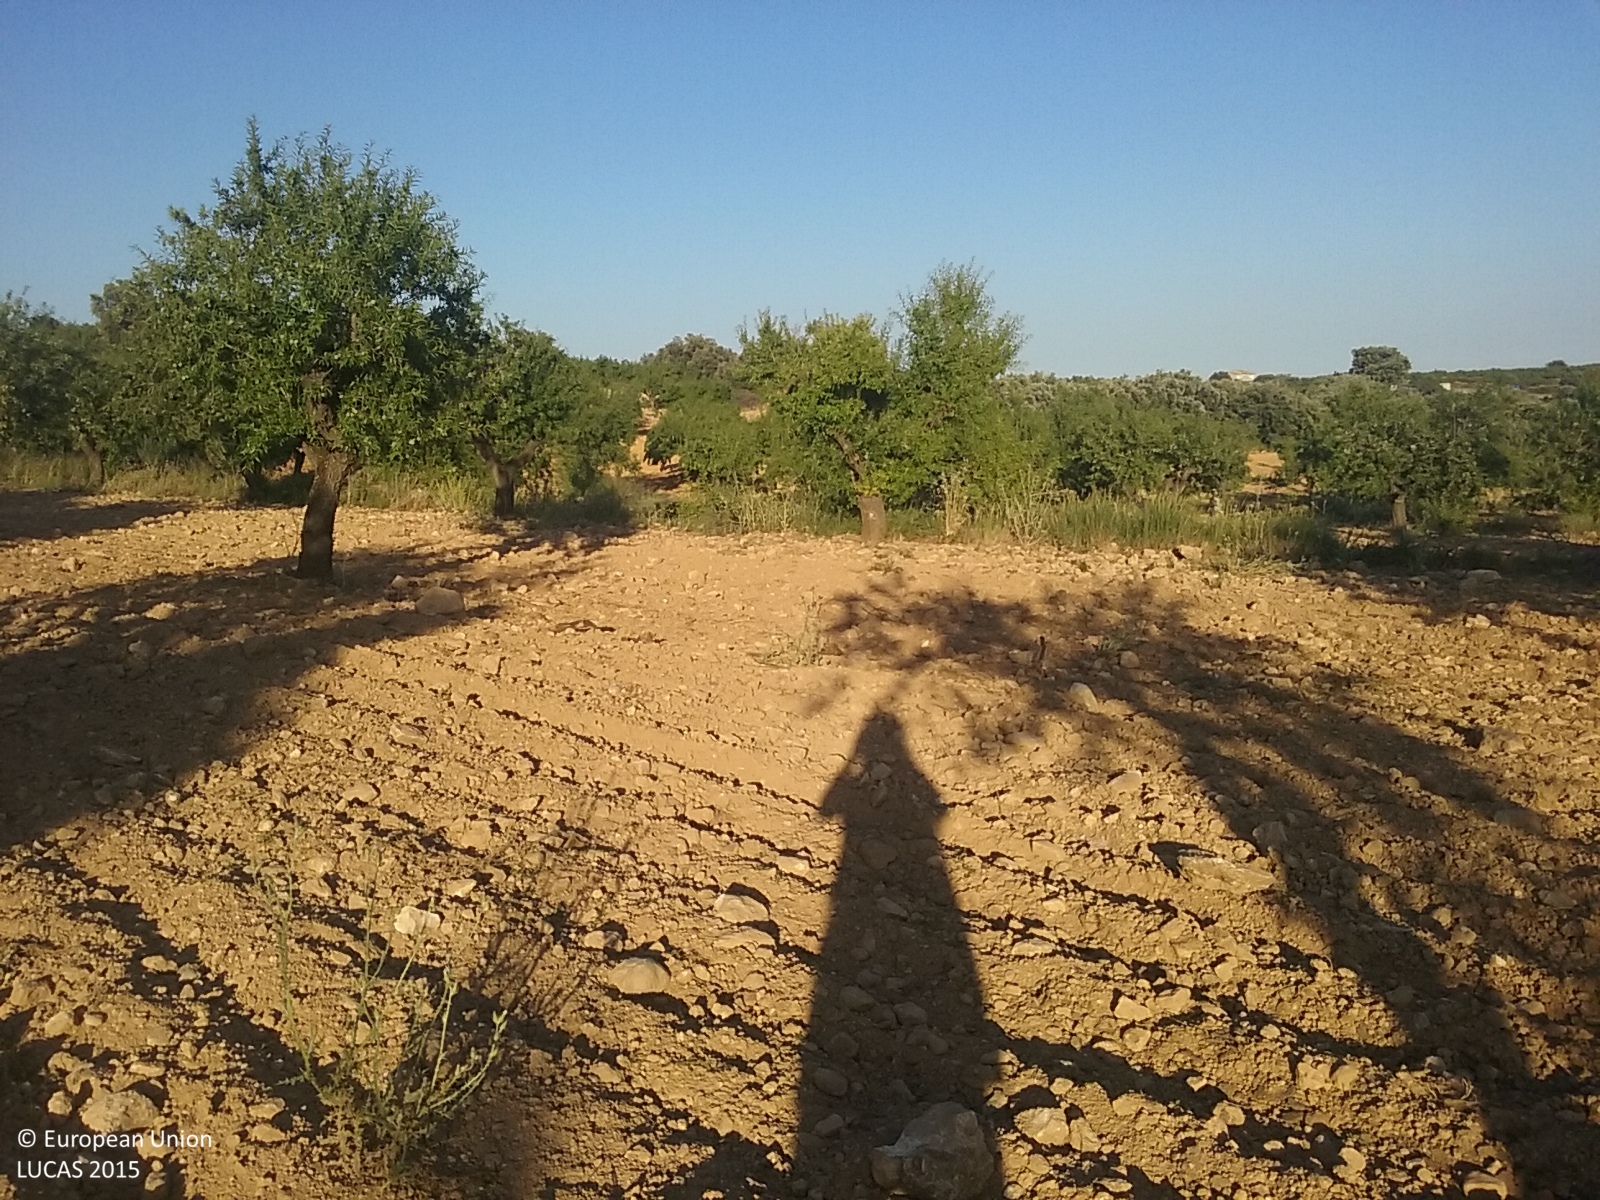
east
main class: Cropland
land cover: Nuts trees
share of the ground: 10 - 25 %
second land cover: Other bare soil
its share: > 75 %
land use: Agriculture (excluding fallow land and kitchen gardens)
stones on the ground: 10 - 25 %
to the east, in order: Nuts trees; Other bare soil; Groves; Grass margins; Nuts trees; Groves; Dry stone walls; Shrubland with sparse tree cover; Tracks; Shrubland with sparse tree cover; Tracks; Shrubland with sparse tree cover; Groves; Nuts trees
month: May
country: ES
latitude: 40.2080
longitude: -0.0250
